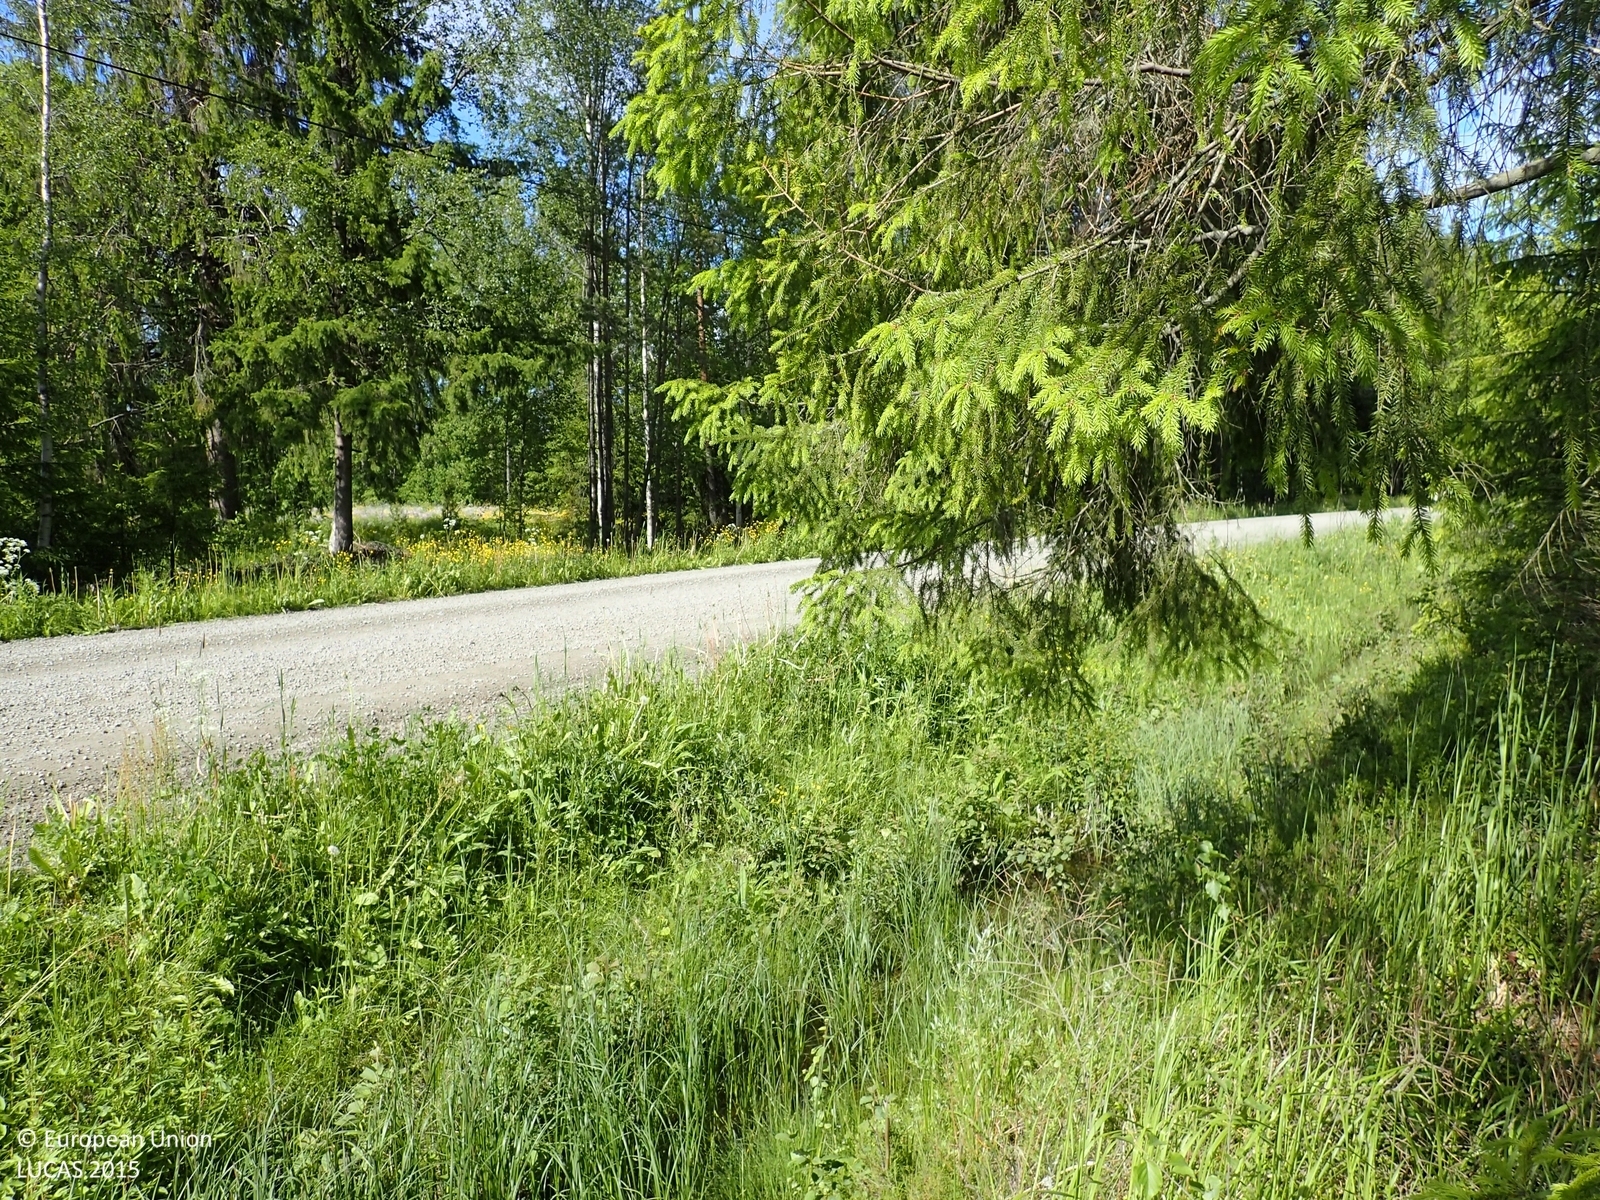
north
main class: Woodland
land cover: Pine dominated coniferous woodland
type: boreal forest
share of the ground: 25 - 50 %
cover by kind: coniferous forest trees 35 %, shrubs 30 %, herbaceous plants 20 %, lichens and mosses 10 %, broadleaved forest trees 5 %
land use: Forestry
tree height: > 5 m
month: June
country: FI
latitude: 62.4534
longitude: 21.6162
